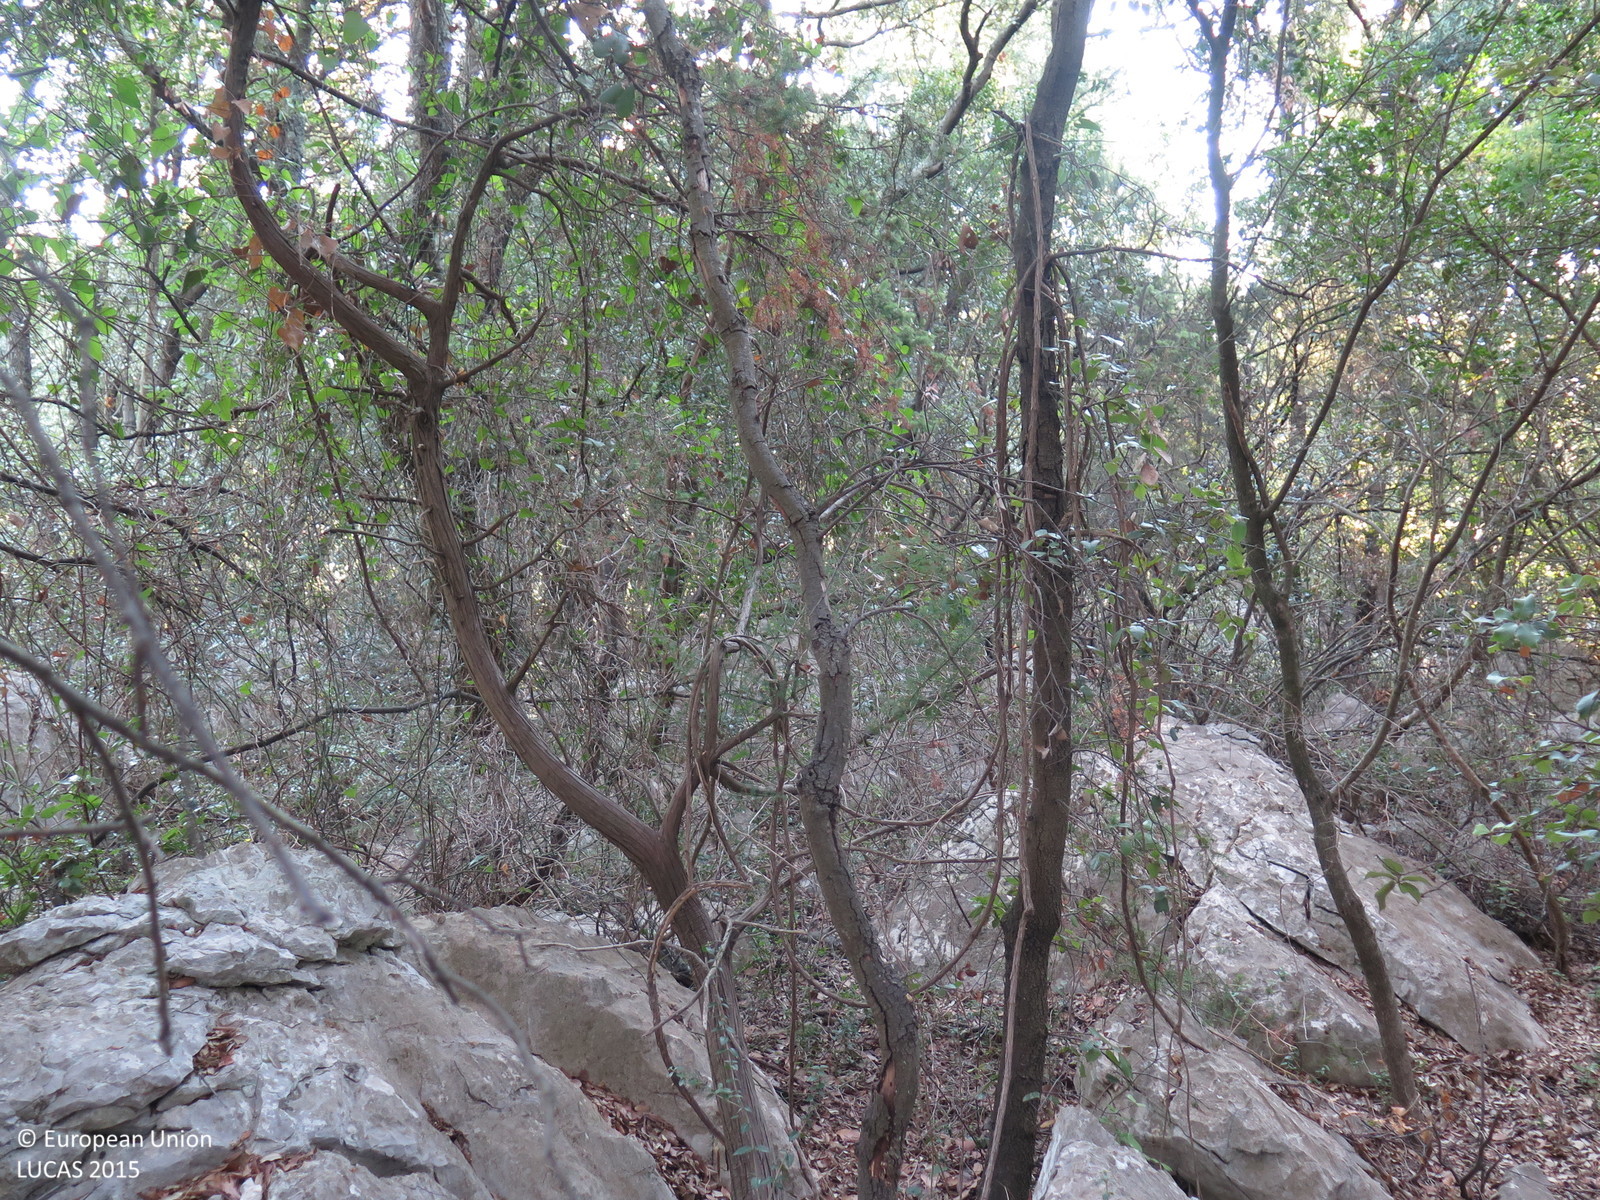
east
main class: Woodland
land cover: Broadleaved woodland
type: thermophilous deciduous forest
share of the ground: > 75 %
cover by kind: broadleaved forest trees 90 %, shrubs 5 %, unconsolidated bare surface 5 %
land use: Forestry
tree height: > 5 m
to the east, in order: Broadleaved woodland
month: August
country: HR
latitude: 44.7676
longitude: 14.7065
